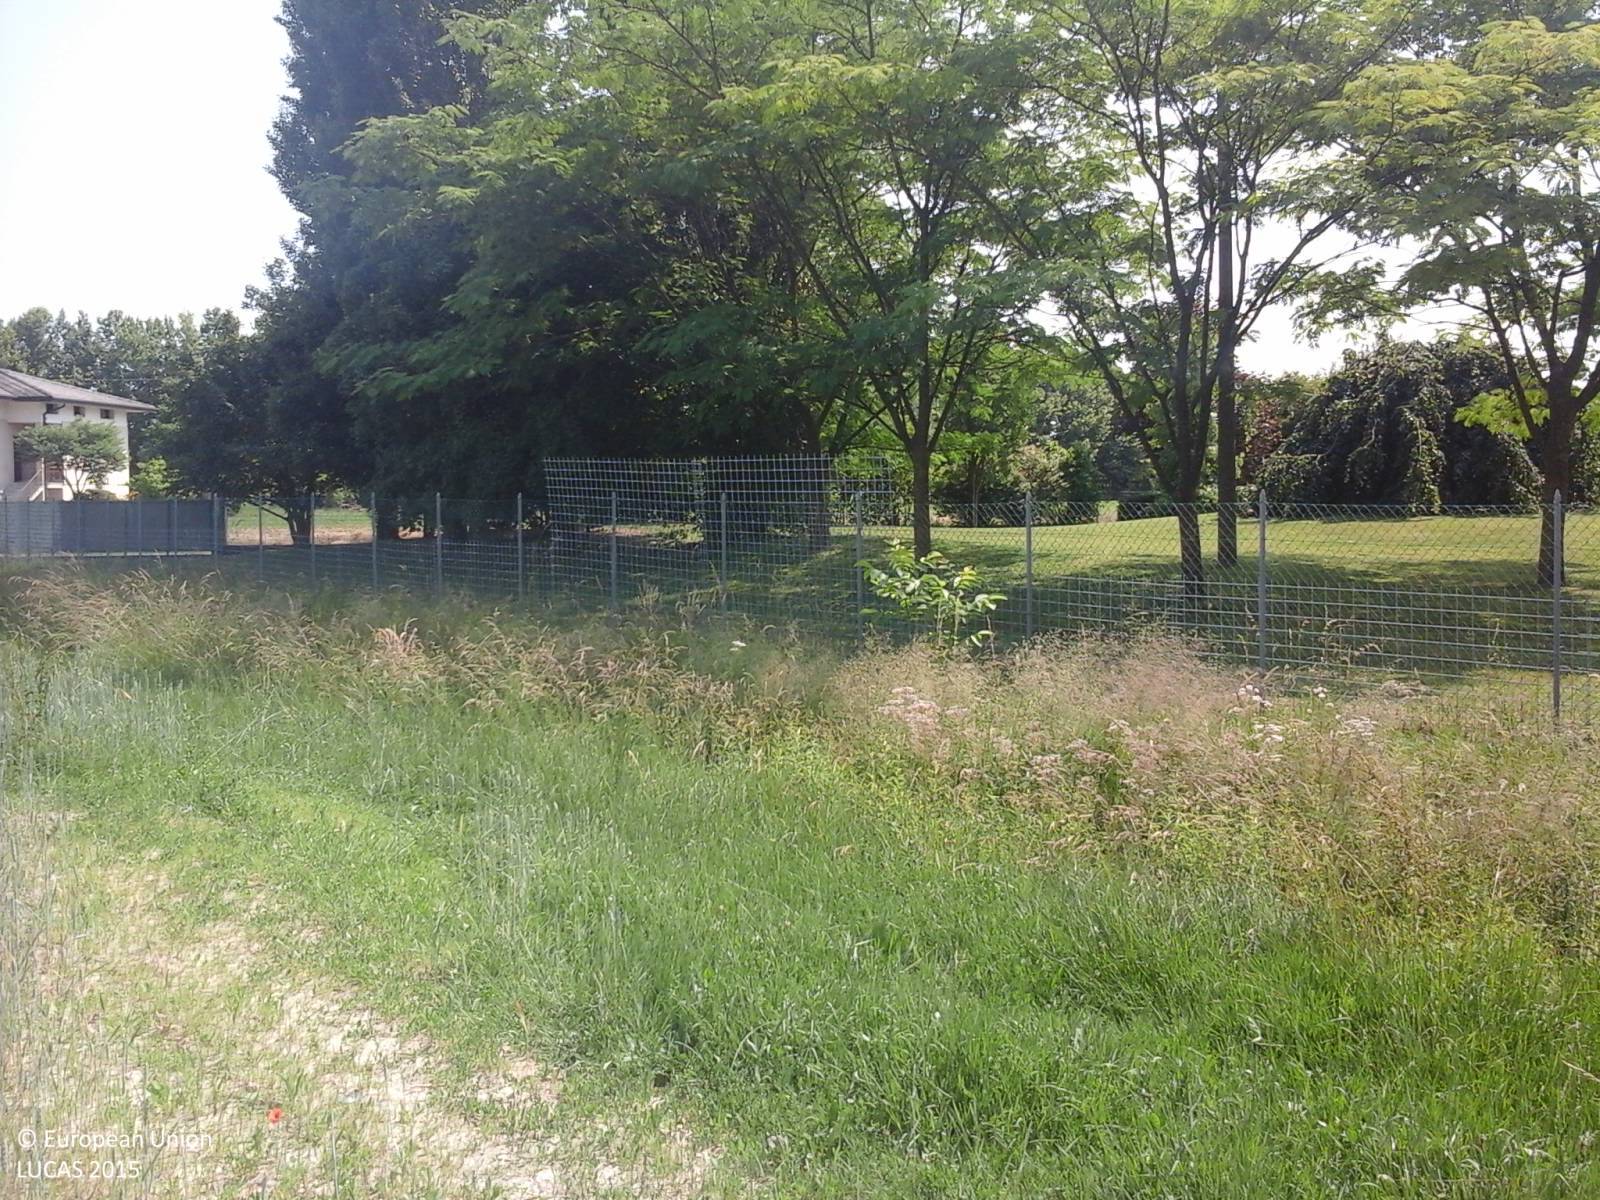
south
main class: Cropland
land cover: Common wheat
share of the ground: > 75 %
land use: Agriculture (excluding fallow land and kitchen gardens)
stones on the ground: < 10 %
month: June
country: IT
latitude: 45.8886
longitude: 12.5353
